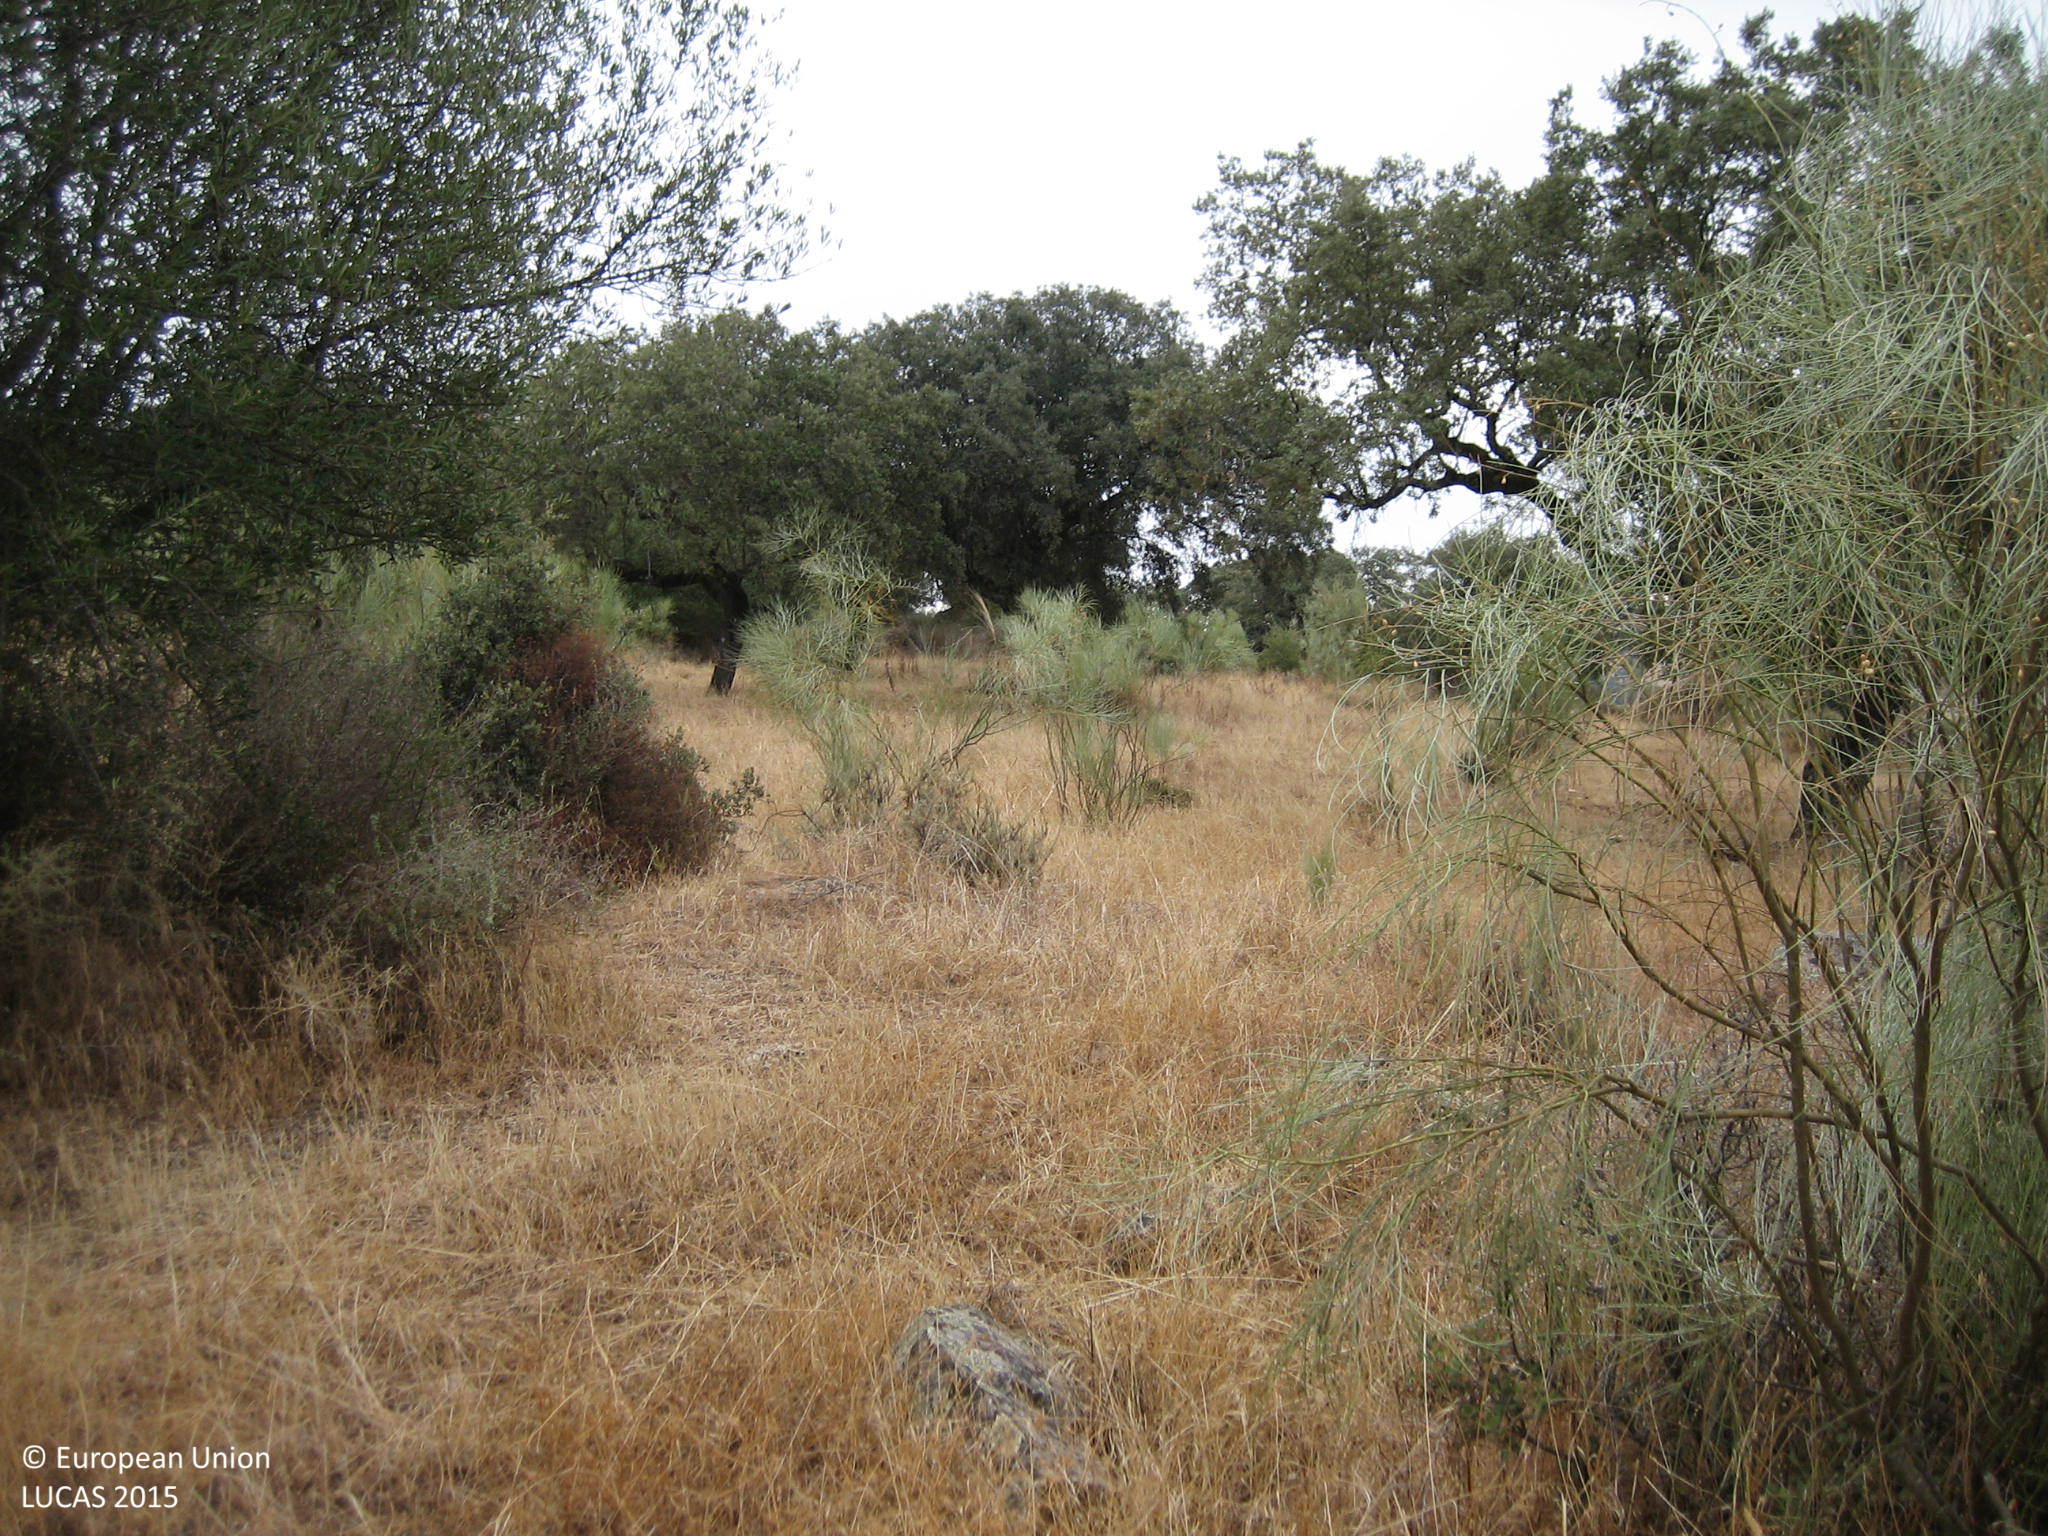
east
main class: Woodland
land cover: Broadleaved woodland
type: broadleaved evergreen forest
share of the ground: 10 - 25 %
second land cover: Shrubland without tree cover
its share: 25 - 50 %
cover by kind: herbaceous plants 55 %, shrubs 30 %, broadleaved forest trees 15 %
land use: Forestry
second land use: Agriculture (excluding fallow land and kitchen gardens)
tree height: > 5 m
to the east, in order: Broadleaved woodland; Shrubland without tree cover; Grassland without tree/shrub cover; Broadleaved woodland
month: September
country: ES
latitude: 38.2817
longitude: -6.8497
